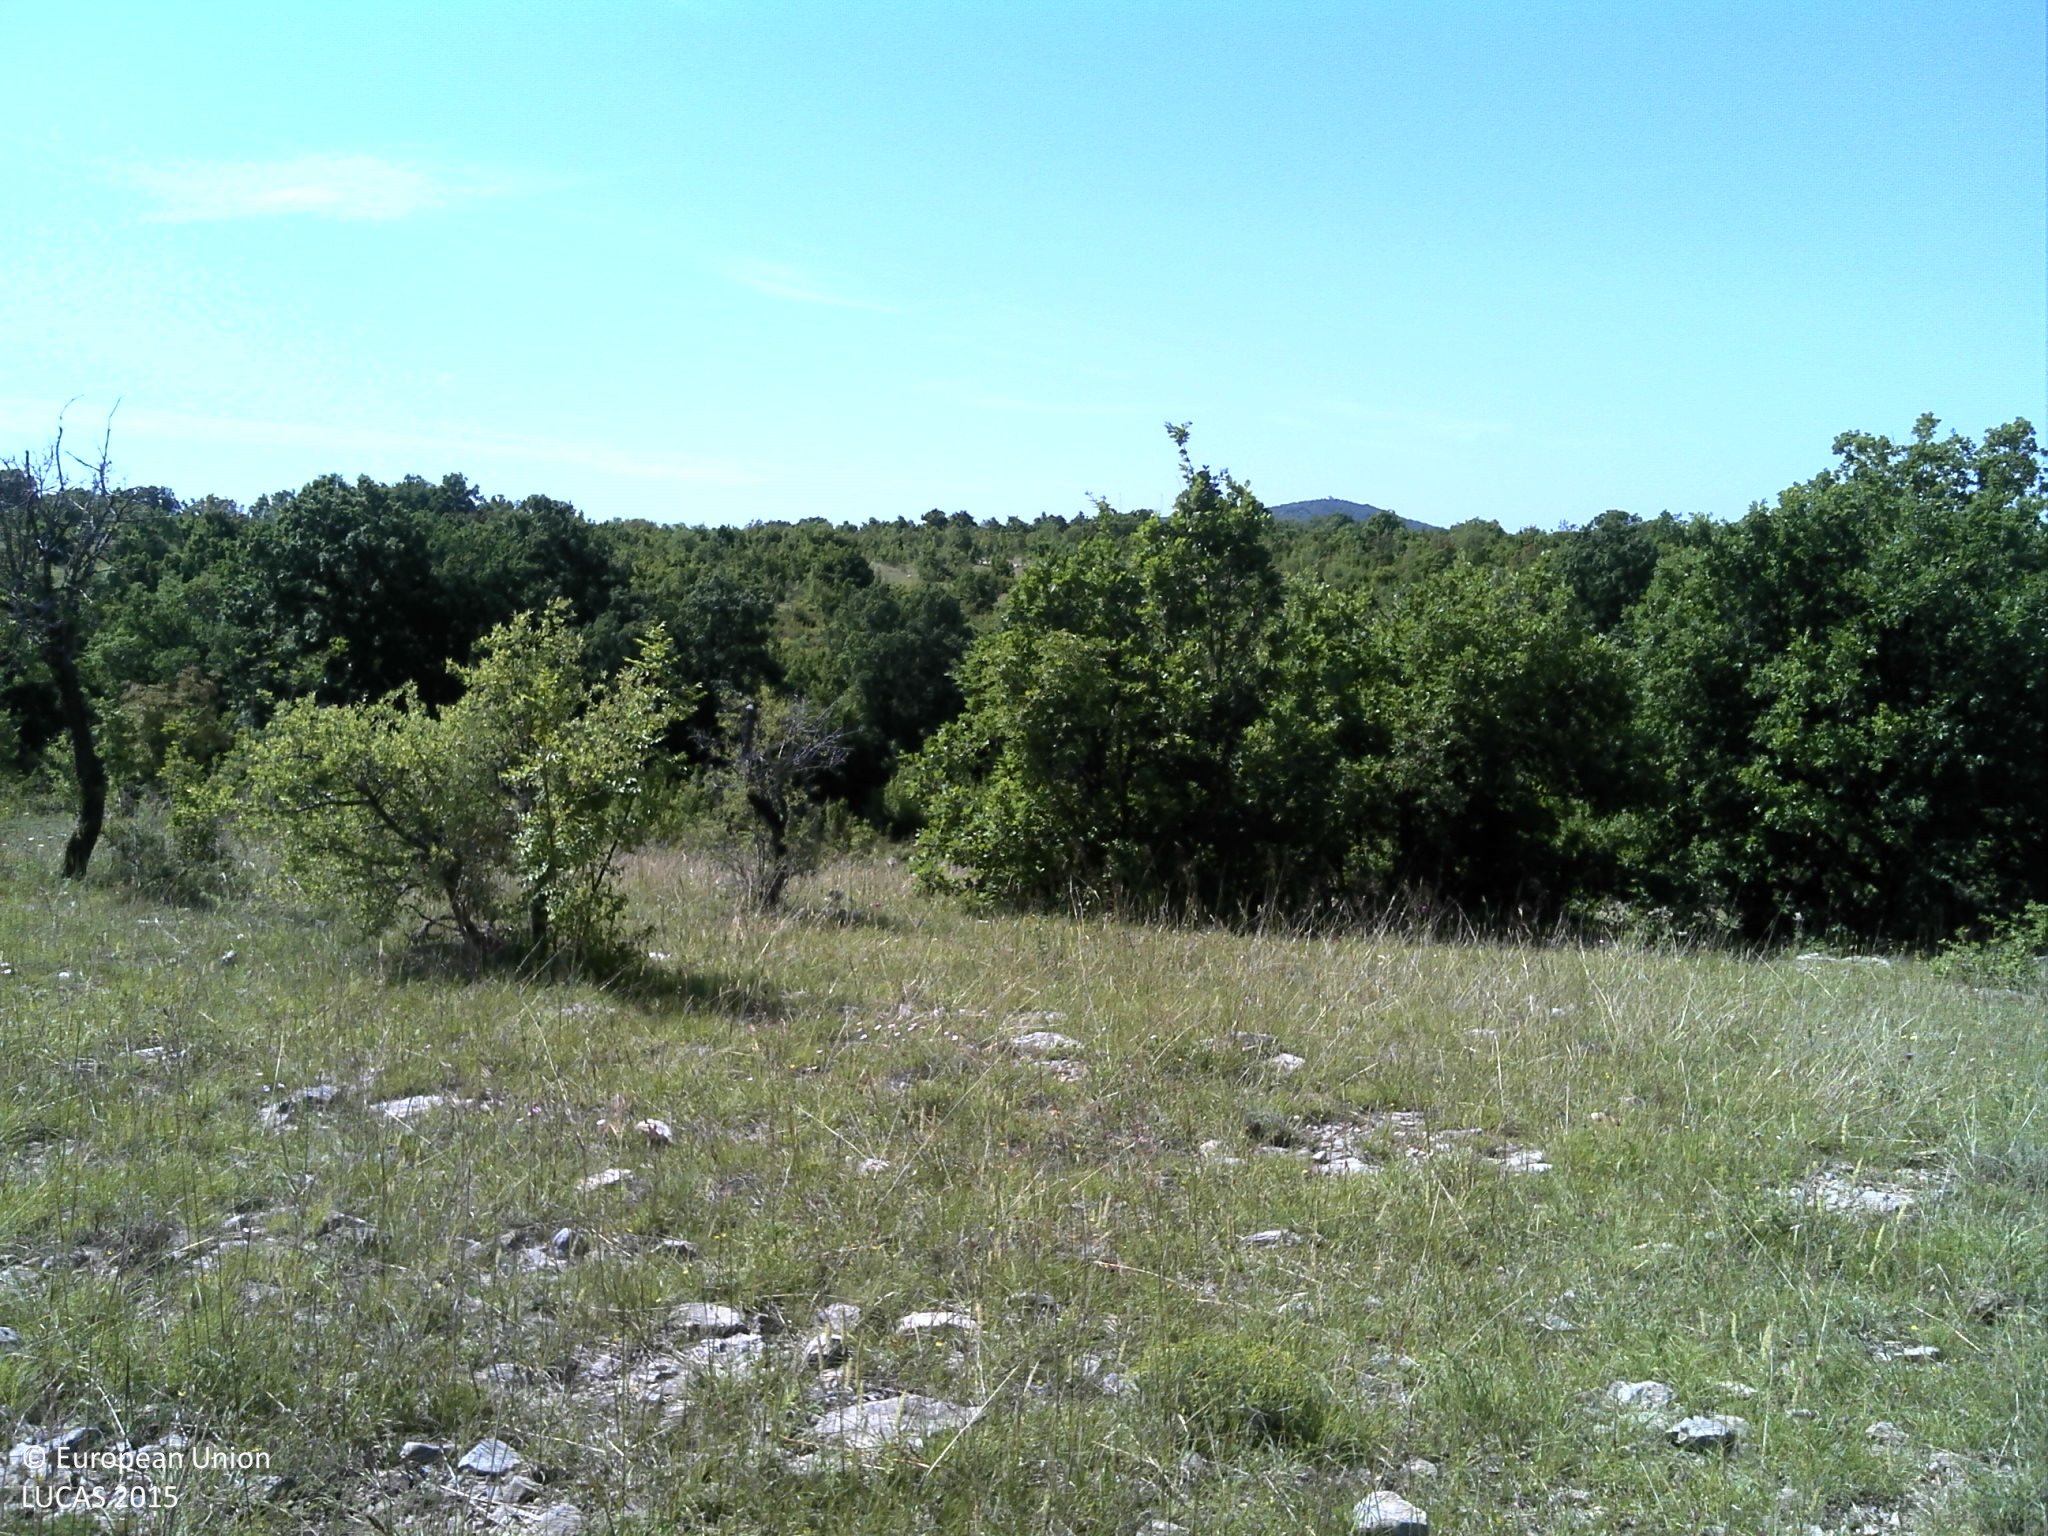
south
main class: Grassland
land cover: Grassland with sparse tree/shrub cover
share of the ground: > 75 %
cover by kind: herbaceous plants 80 %, shrubs 10 %, broadleaved forest trees 5 %, unconsolidated bare surface 5 %
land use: Abandoned areas
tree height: < 5 m
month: June
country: HR
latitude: 43.7498
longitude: 16.1884
